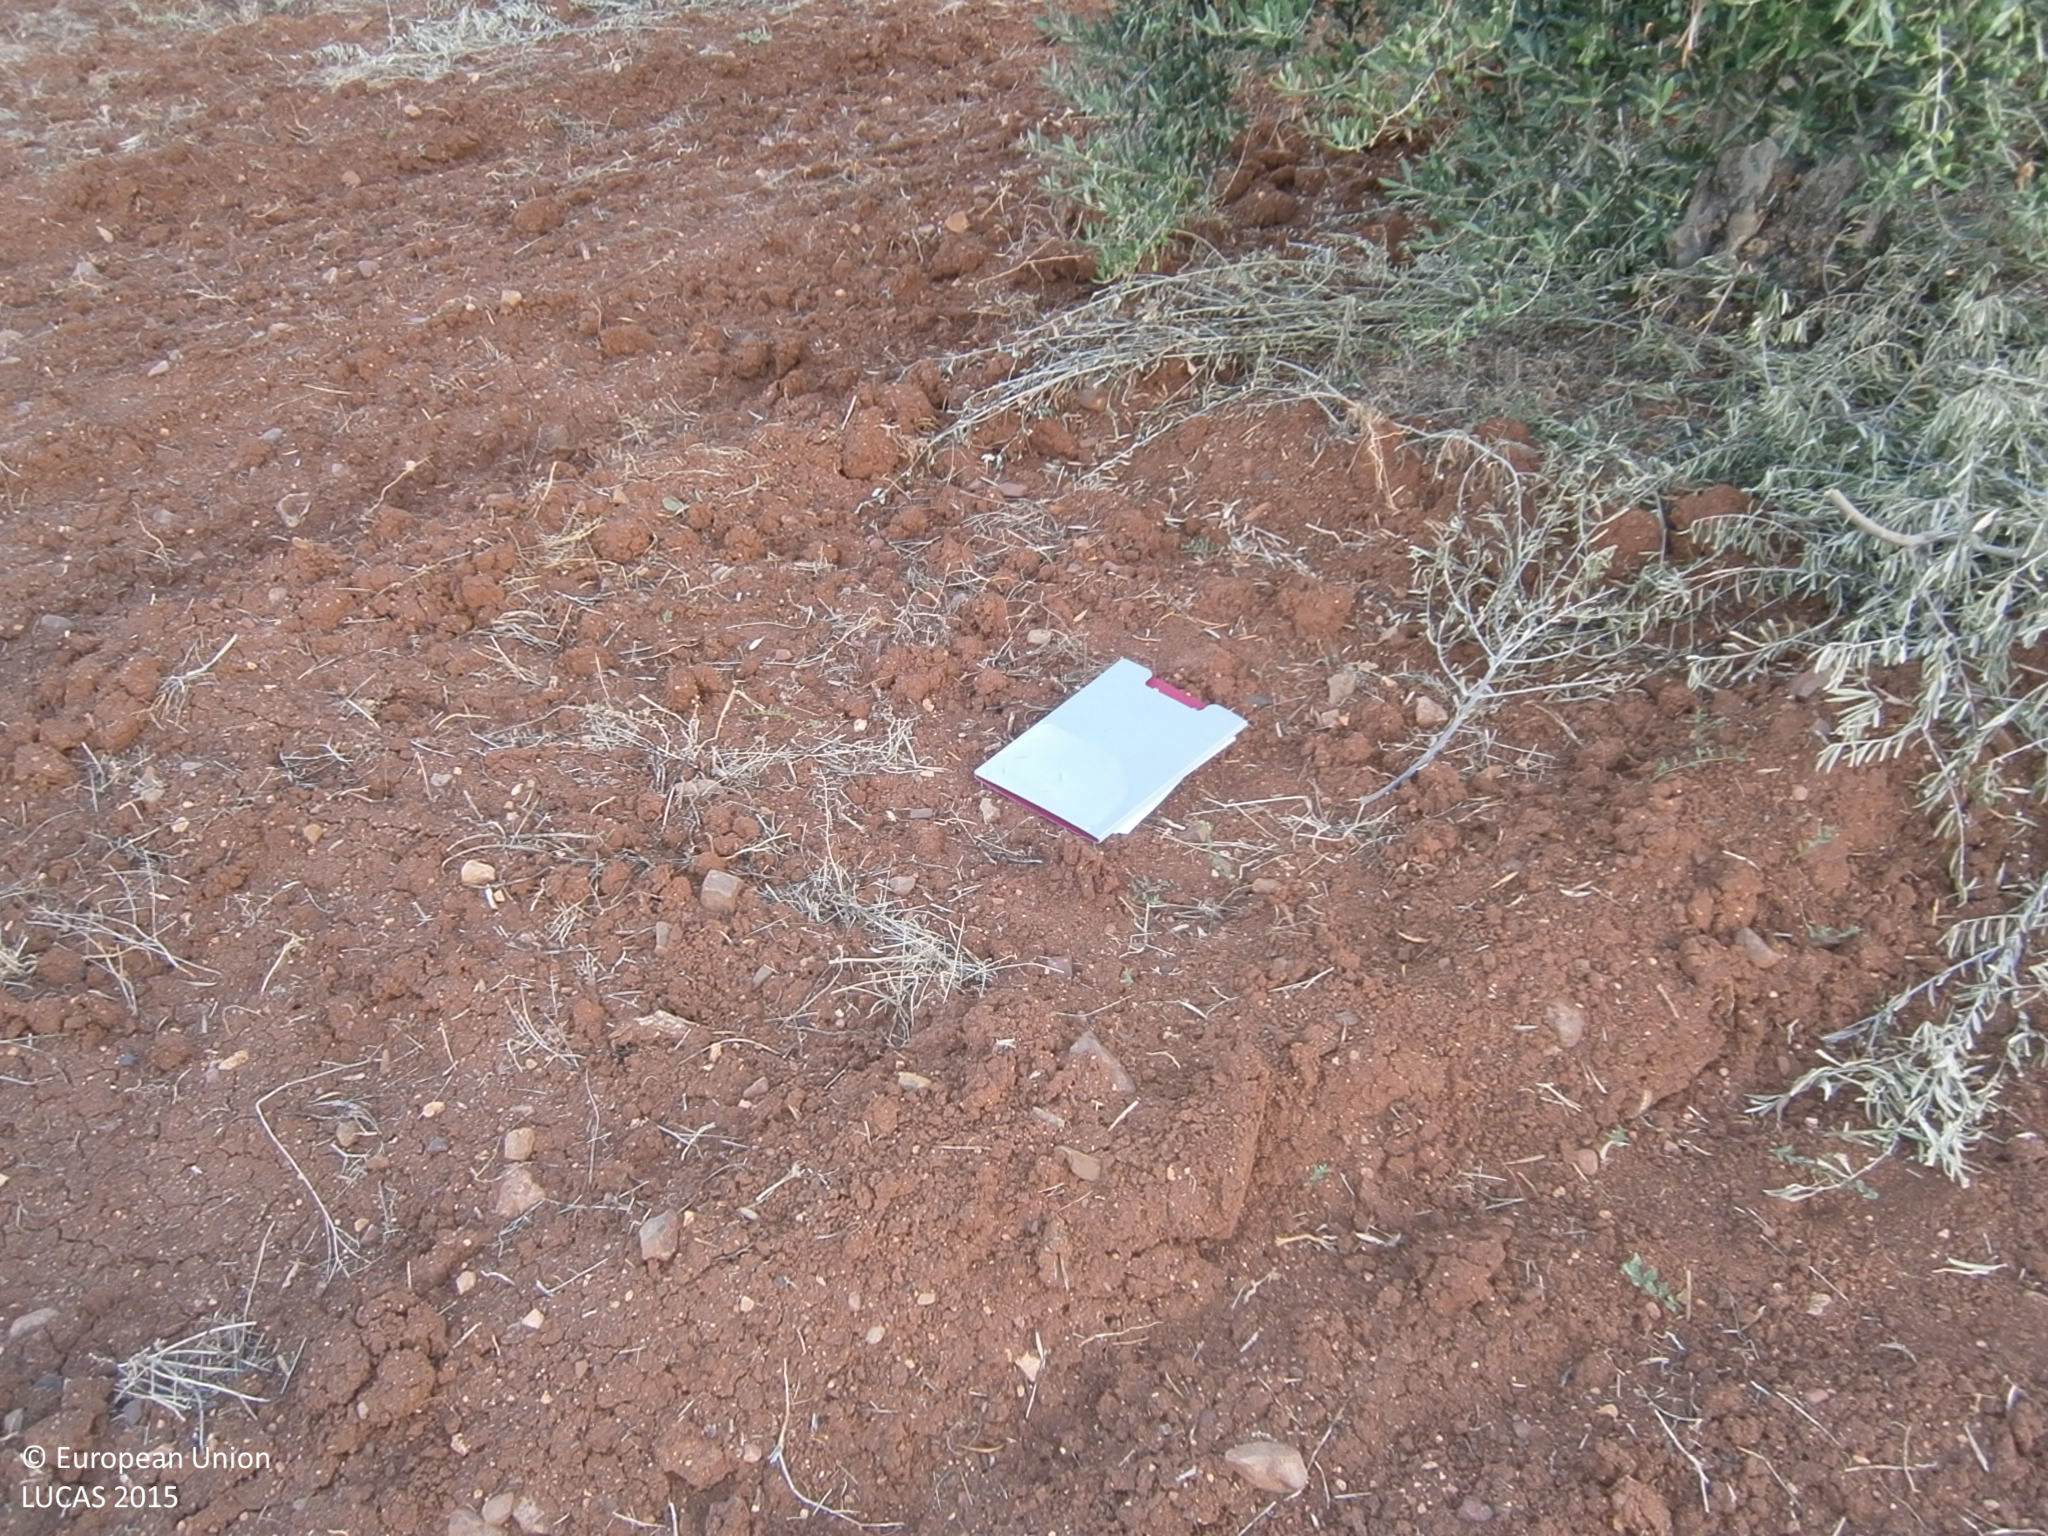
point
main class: Cropland
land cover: Olive groves
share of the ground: 25 - 50 %
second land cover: Other bare soil
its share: > 75 %
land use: Agriculture (excluding fallow land and kitchen gardens)
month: June
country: ES
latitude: 38.6253
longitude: -6.6799
